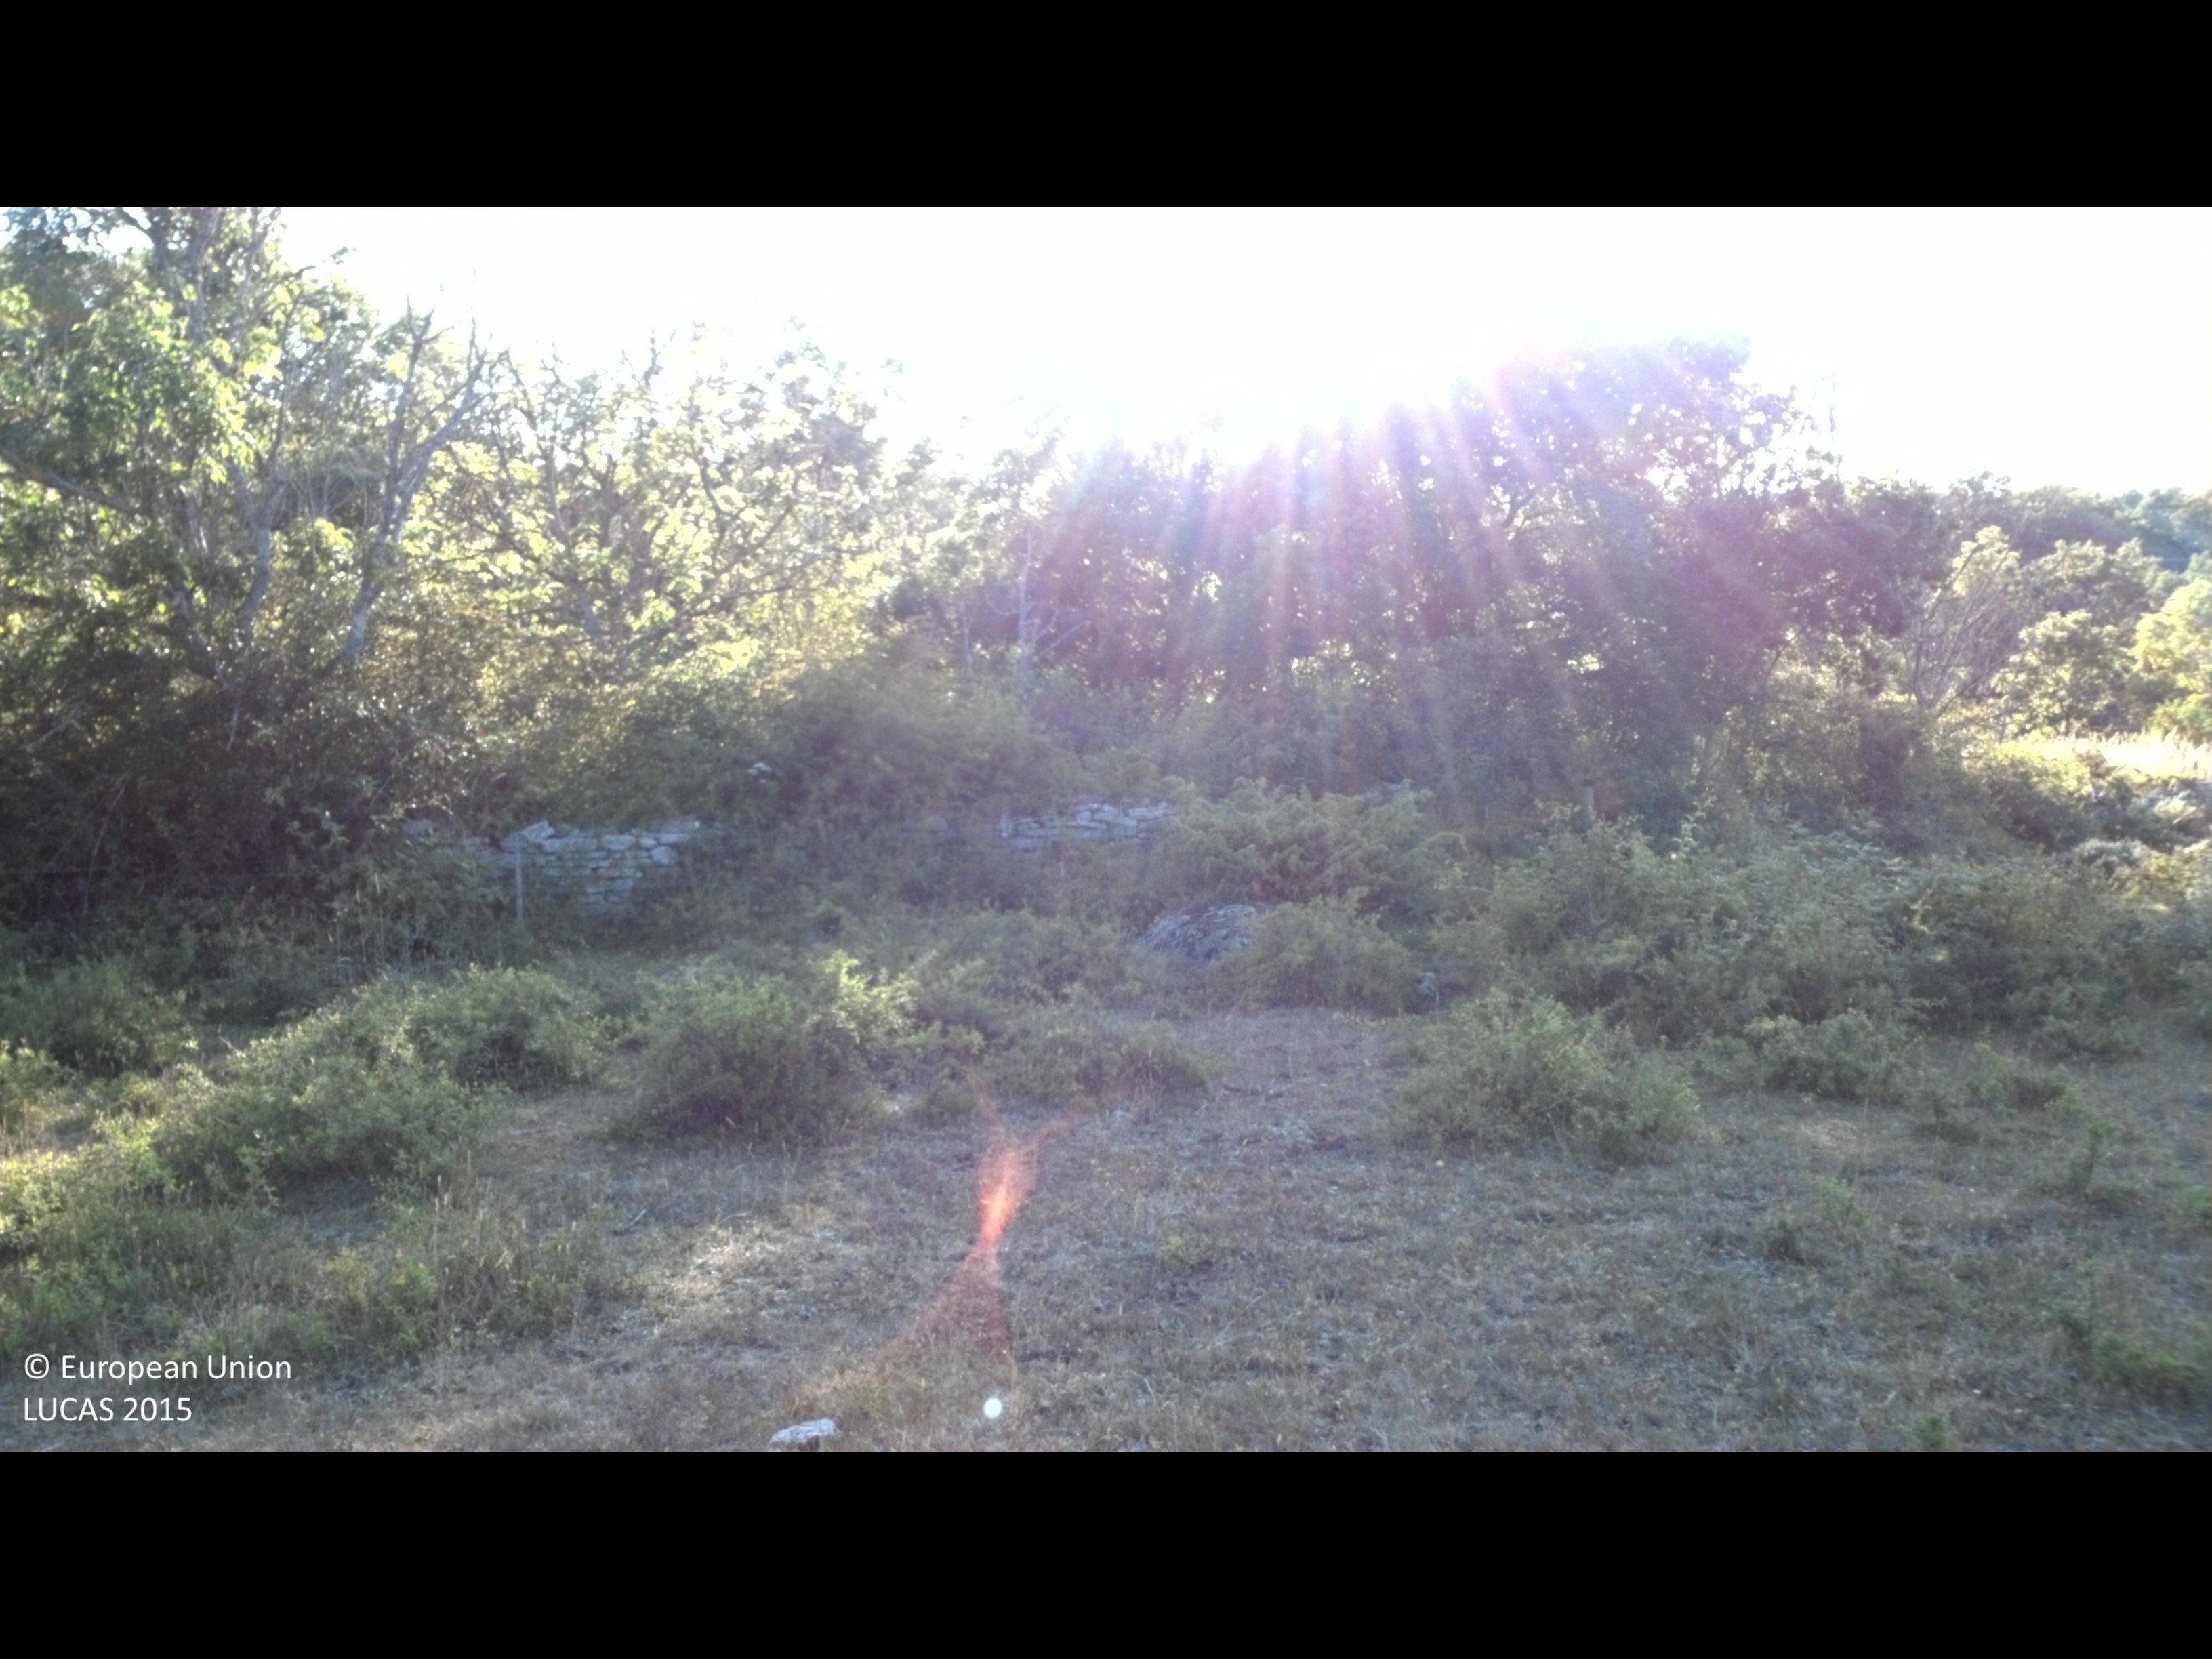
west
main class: Grassland
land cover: Grassland with sparse tree/shrub cover
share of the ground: > 75 %
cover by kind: herbaceous plants 90 %, broadleaved forest trees 5 %, shrubs 5 %
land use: Agriculture (excluding fallow land and kitchen gardens)
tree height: < 5 m
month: July
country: SE
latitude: 56.3157
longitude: 16.4202
